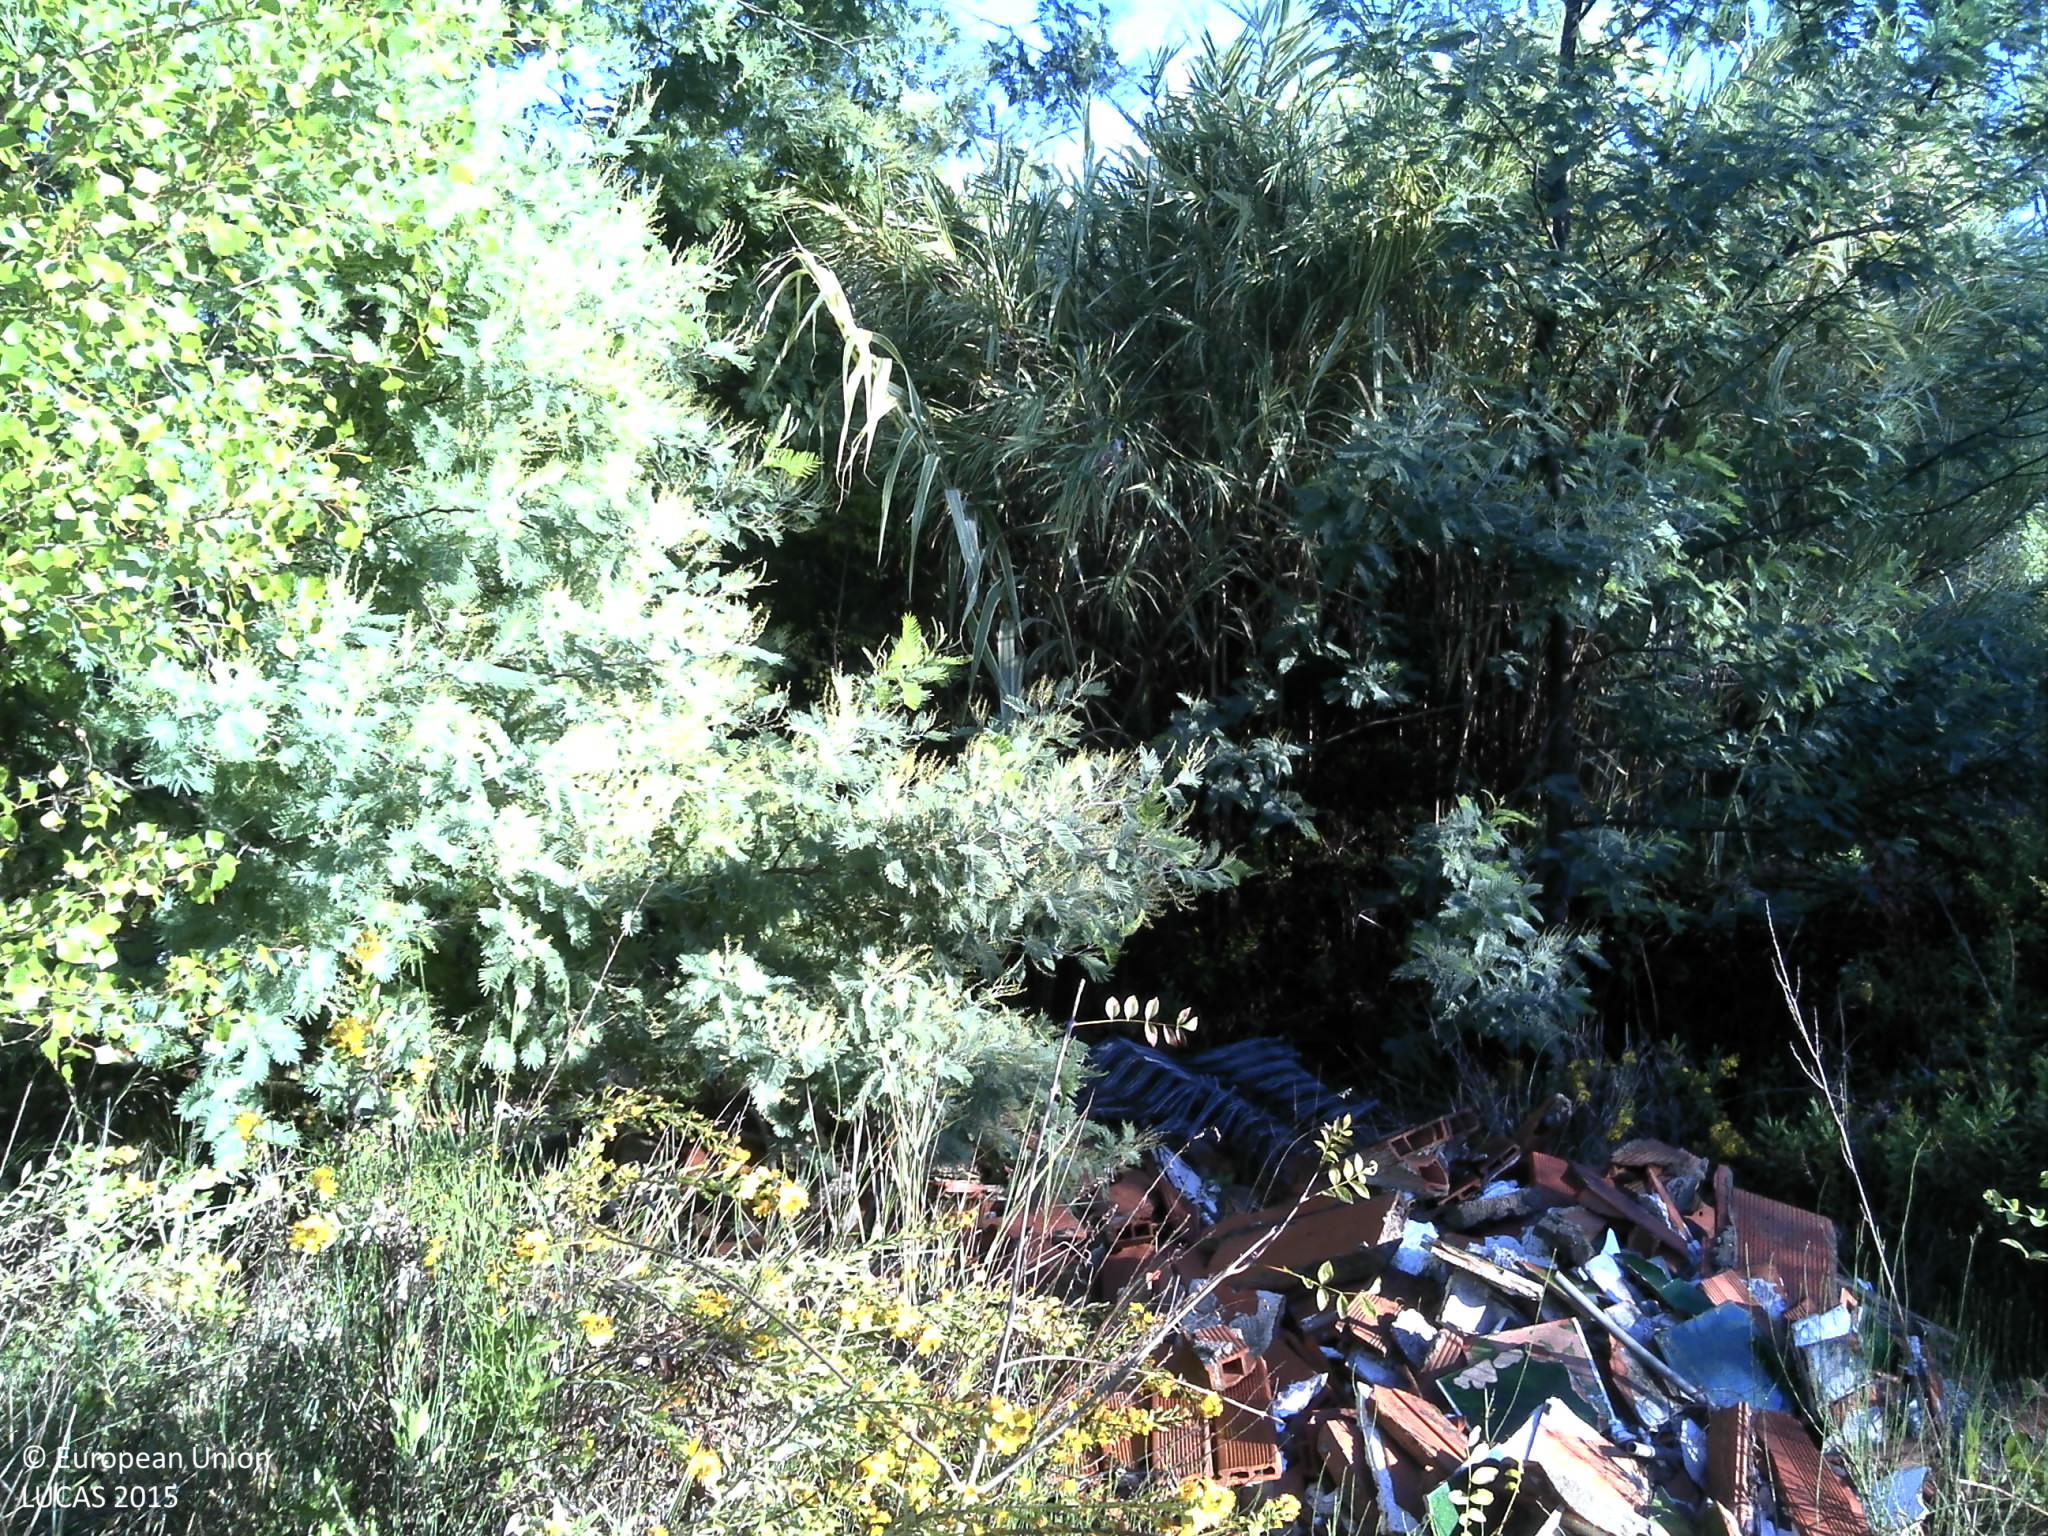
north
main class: Woodland
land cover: Pine dominated mixed woodland
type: thermophilous deciduous forest
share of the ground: > 75 %
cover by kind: broadleaved forest trees 55 %, coniferous forest trees 25 %, shrubs 15 %, herbaceous plants 5 %
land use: Semi-natural and natural areas not in use
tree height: < 5 m
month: October
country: FR
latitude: 43.4654
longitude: 6.6339
